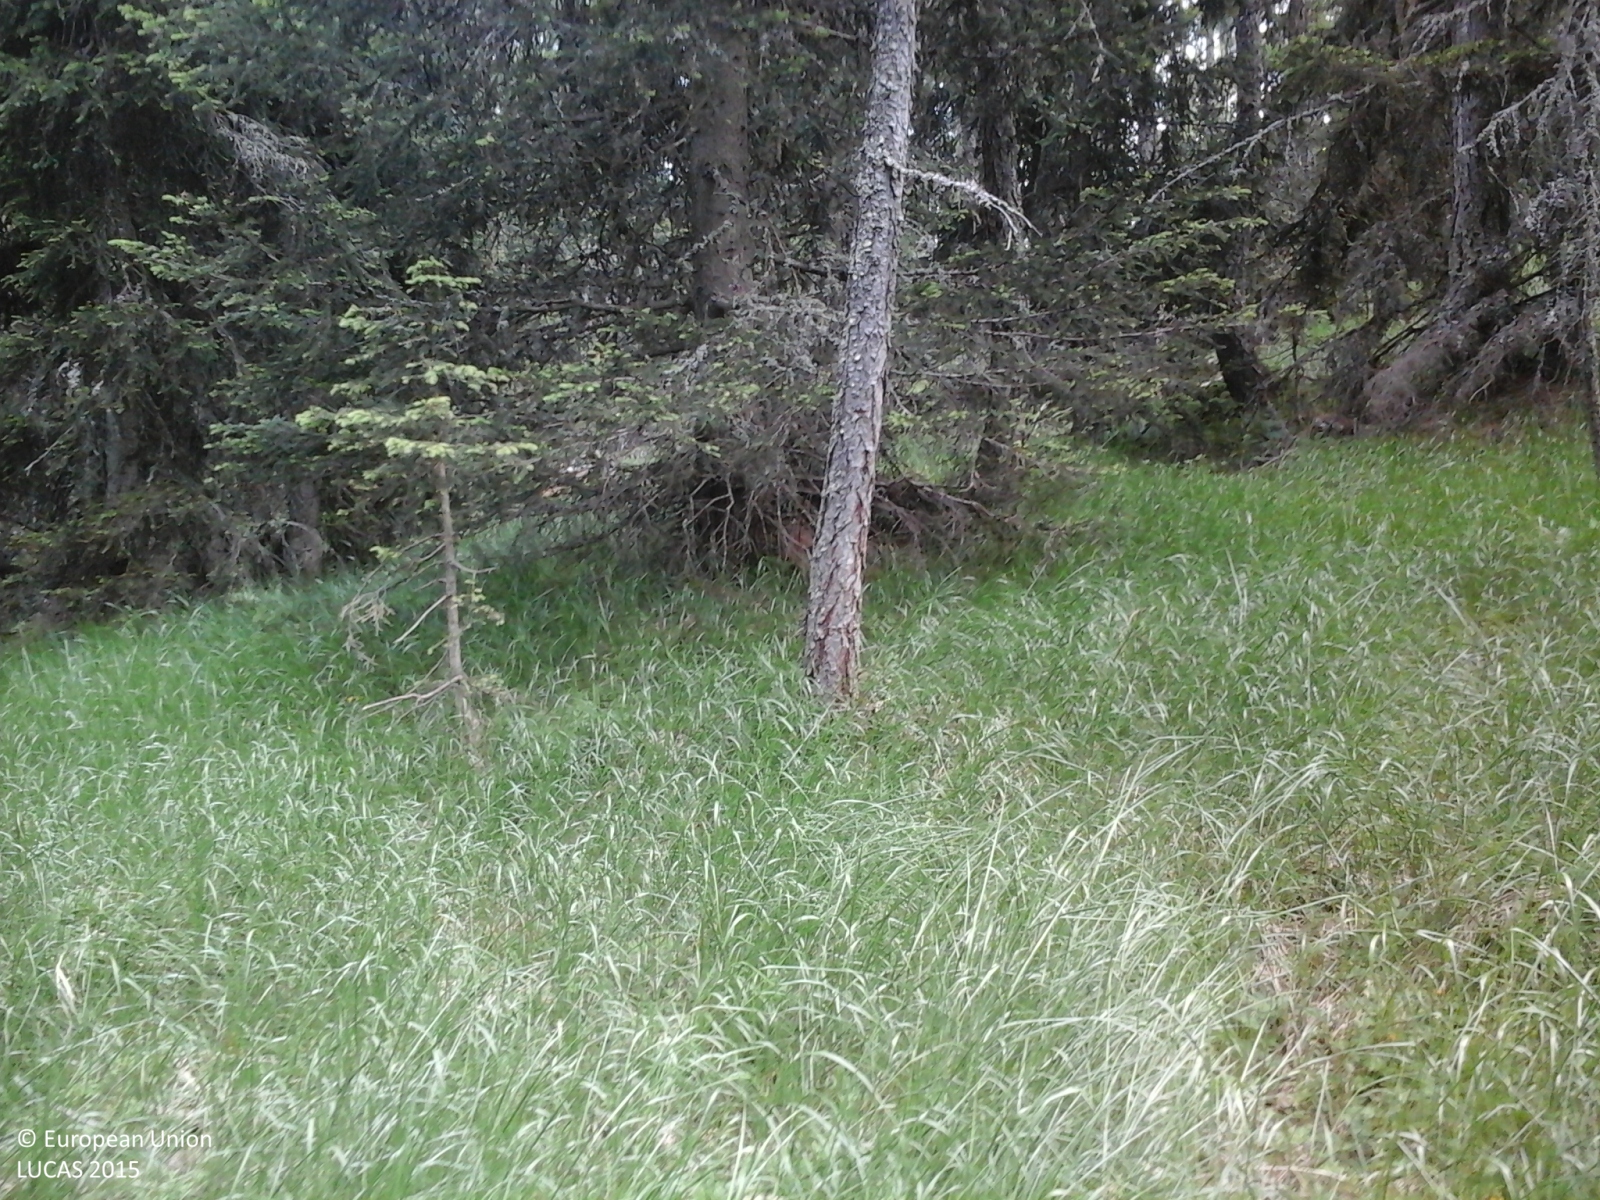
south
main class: Woodland
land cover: Other coniferous woodland
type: alpine coniferous forest
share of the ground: > 75 %
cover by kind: coniferous forest trees 100 %
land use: Forestry
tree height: > 5 m
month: July
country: IT
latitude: 45.8004
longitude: 7.5459
